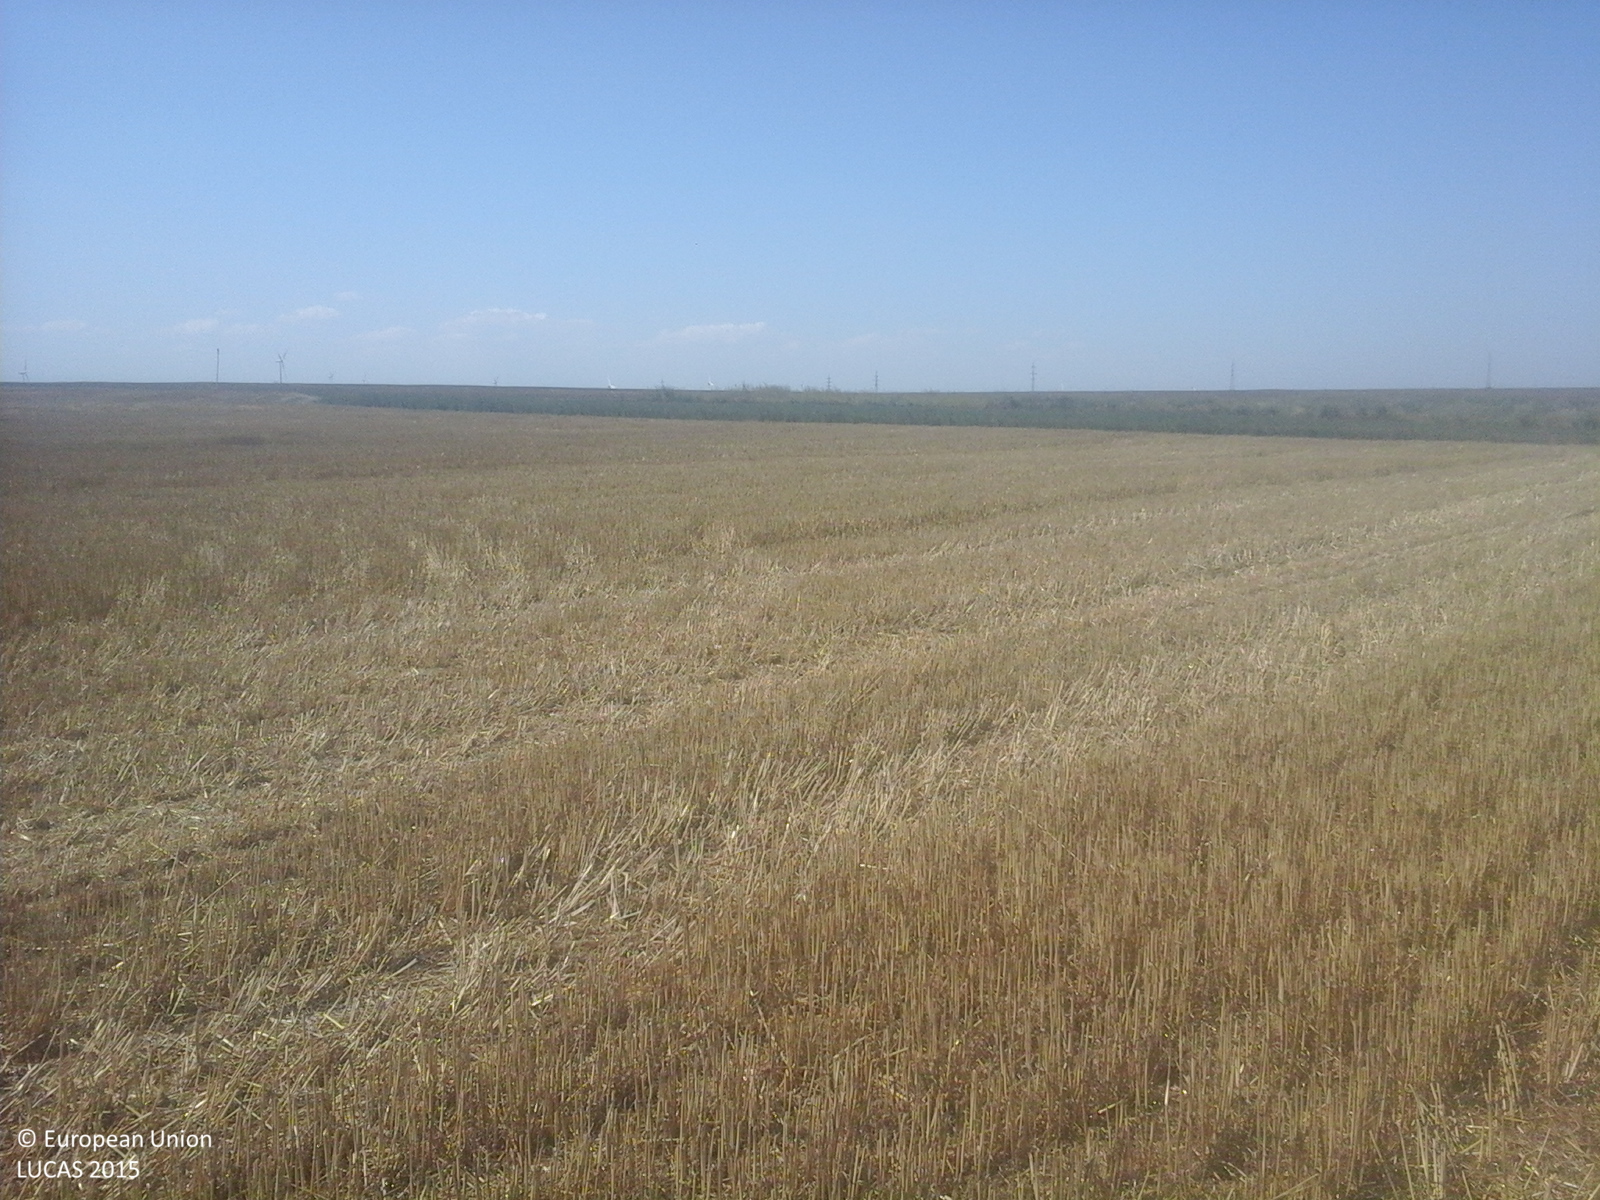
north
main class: Cropland
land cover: Common wheat
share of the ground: > 75 %
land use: Agriculture (excluding fallow land and kitchen gardens)
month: August
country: RO
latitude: 44.4240
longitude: 28.3950
